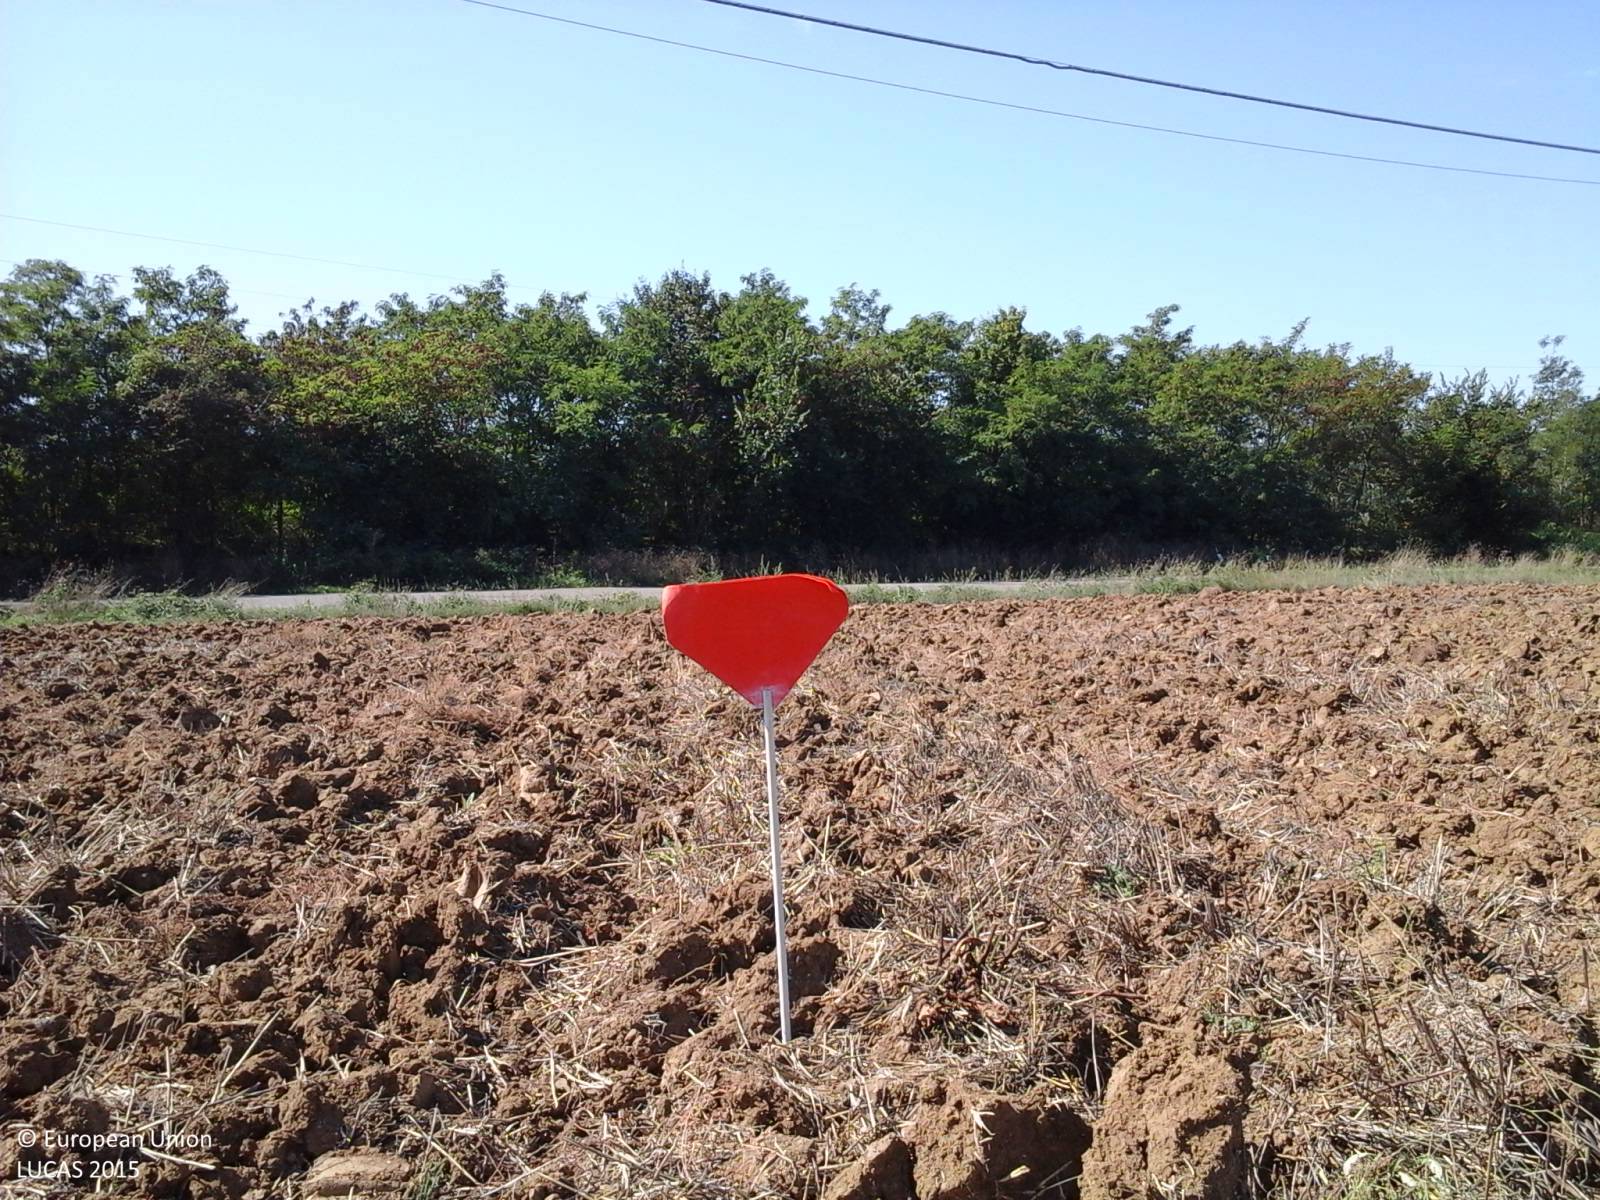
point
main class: Cropland
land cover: Common wheat
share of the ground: < 10 %
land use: Agriculture (excluding fallow land and kitchen gardens)
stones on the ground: 10 - 25 %
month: September
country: IT
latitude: 43.0092
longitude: 12.2140
